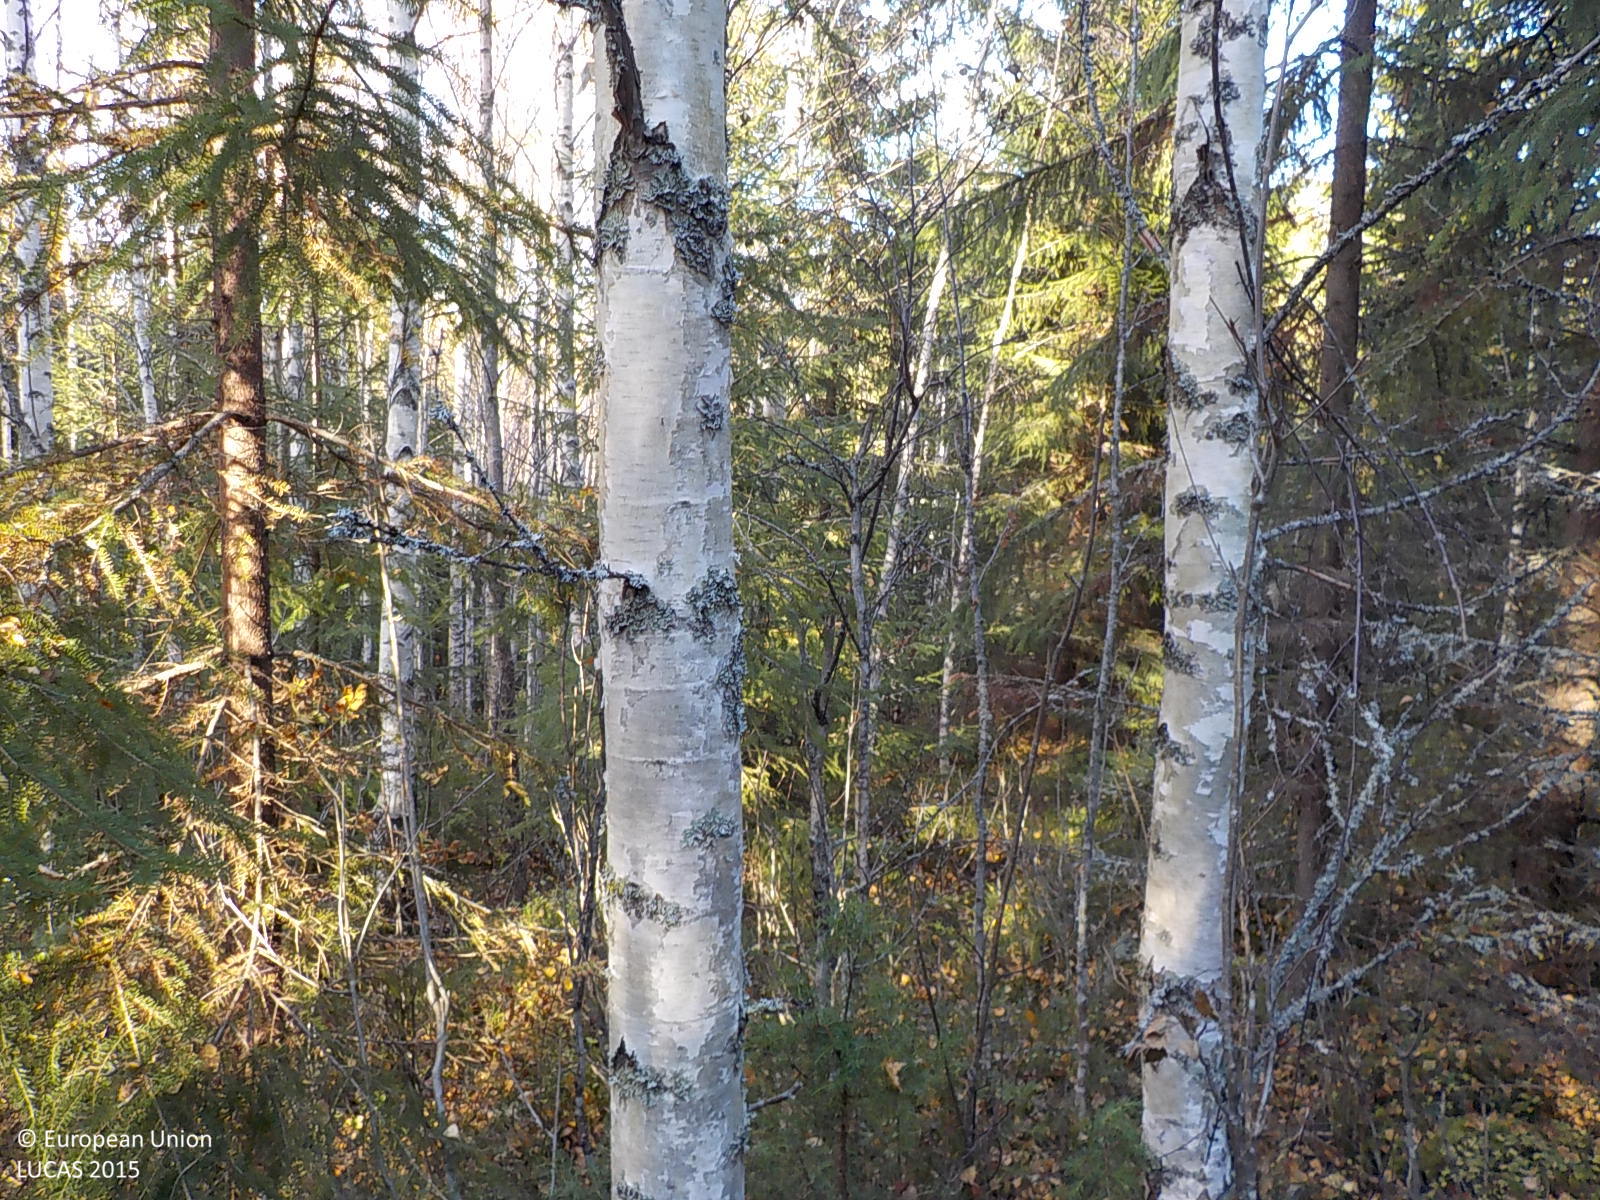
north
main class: Woodland
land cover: Broadleaved woodland
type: hemiboreal forest and nemoral coniferous forest and mixed broadleaved-coniferous forest
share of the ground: 50 - 75 %
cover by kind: broadleaved forest trees 60 %, shrubs 20 %, coniferous forest trees 10 %, lichens and mosses 10 %
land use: Forestry
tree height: > 5 m
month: October
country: SE
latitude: 62.9828
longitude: 18.2862
